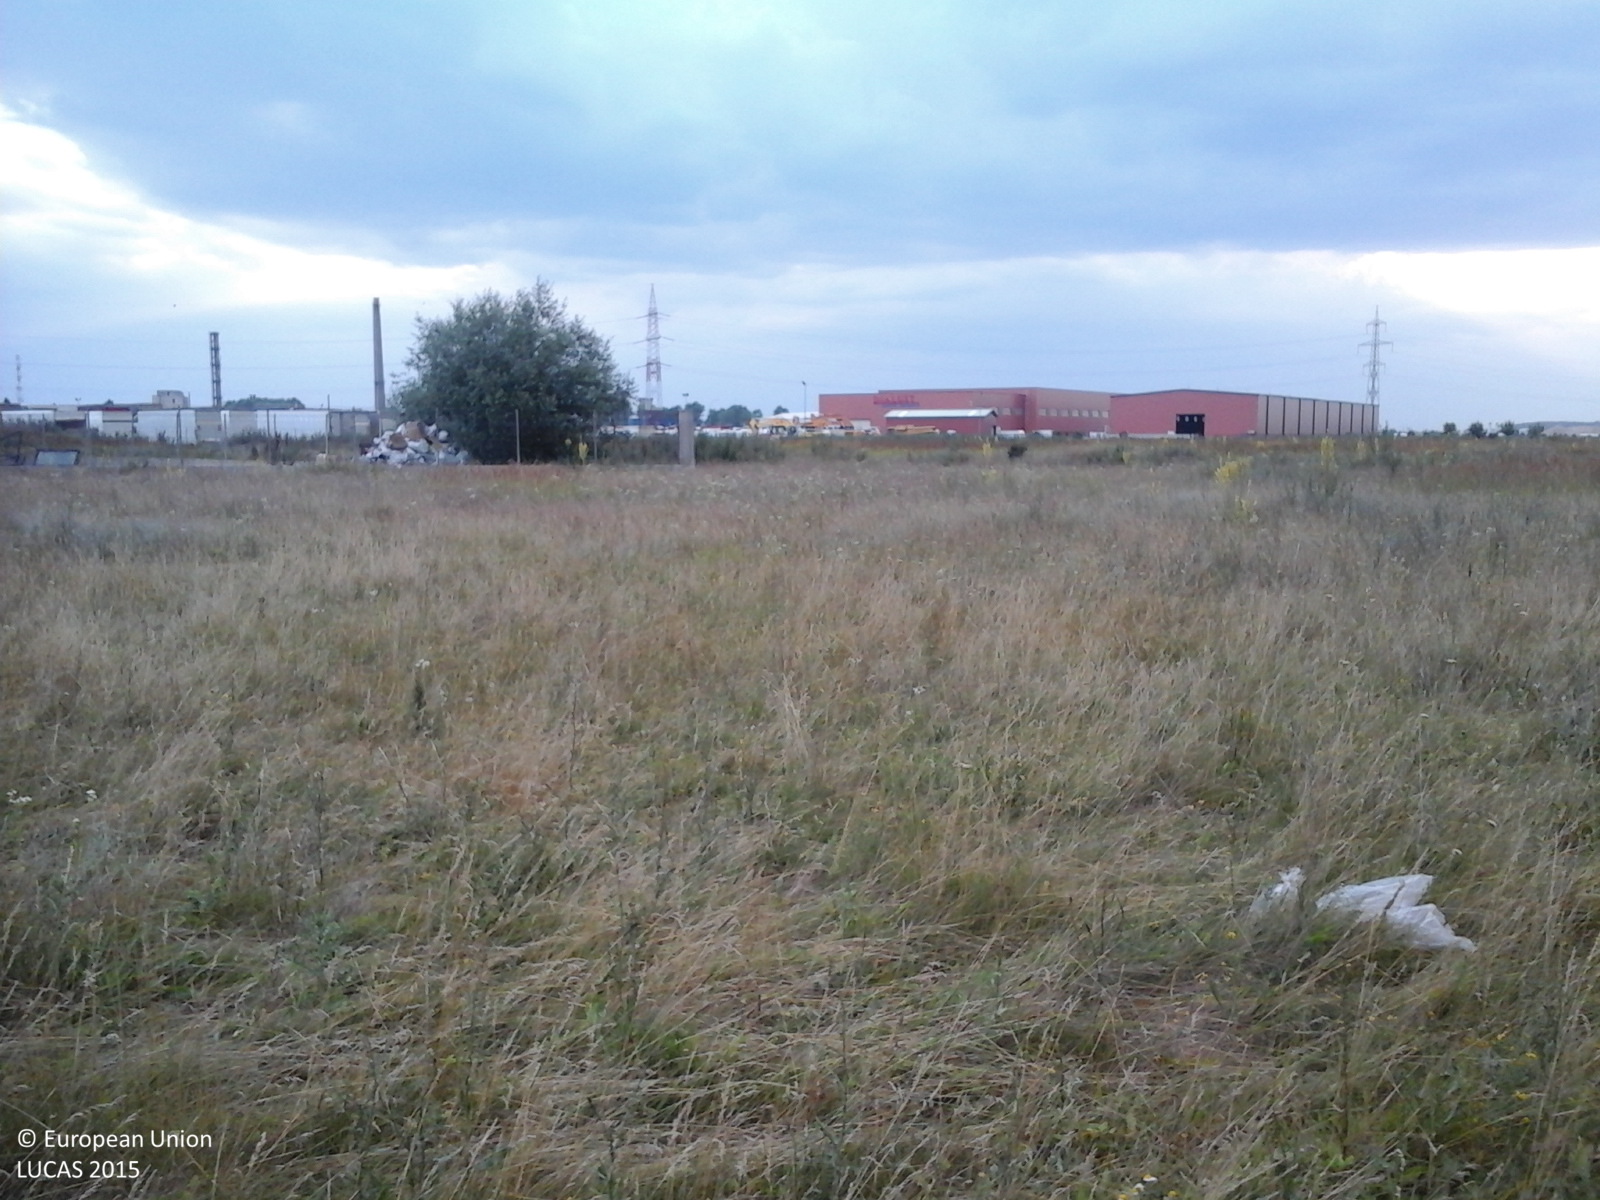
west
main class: Grassland
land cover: Spontaneously vegetated surfaces
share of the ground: > 75 %
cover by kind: herbaceous plants 100 %
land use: Fallow land
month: June
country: RO
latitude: 44.4541
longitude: 26.2579
